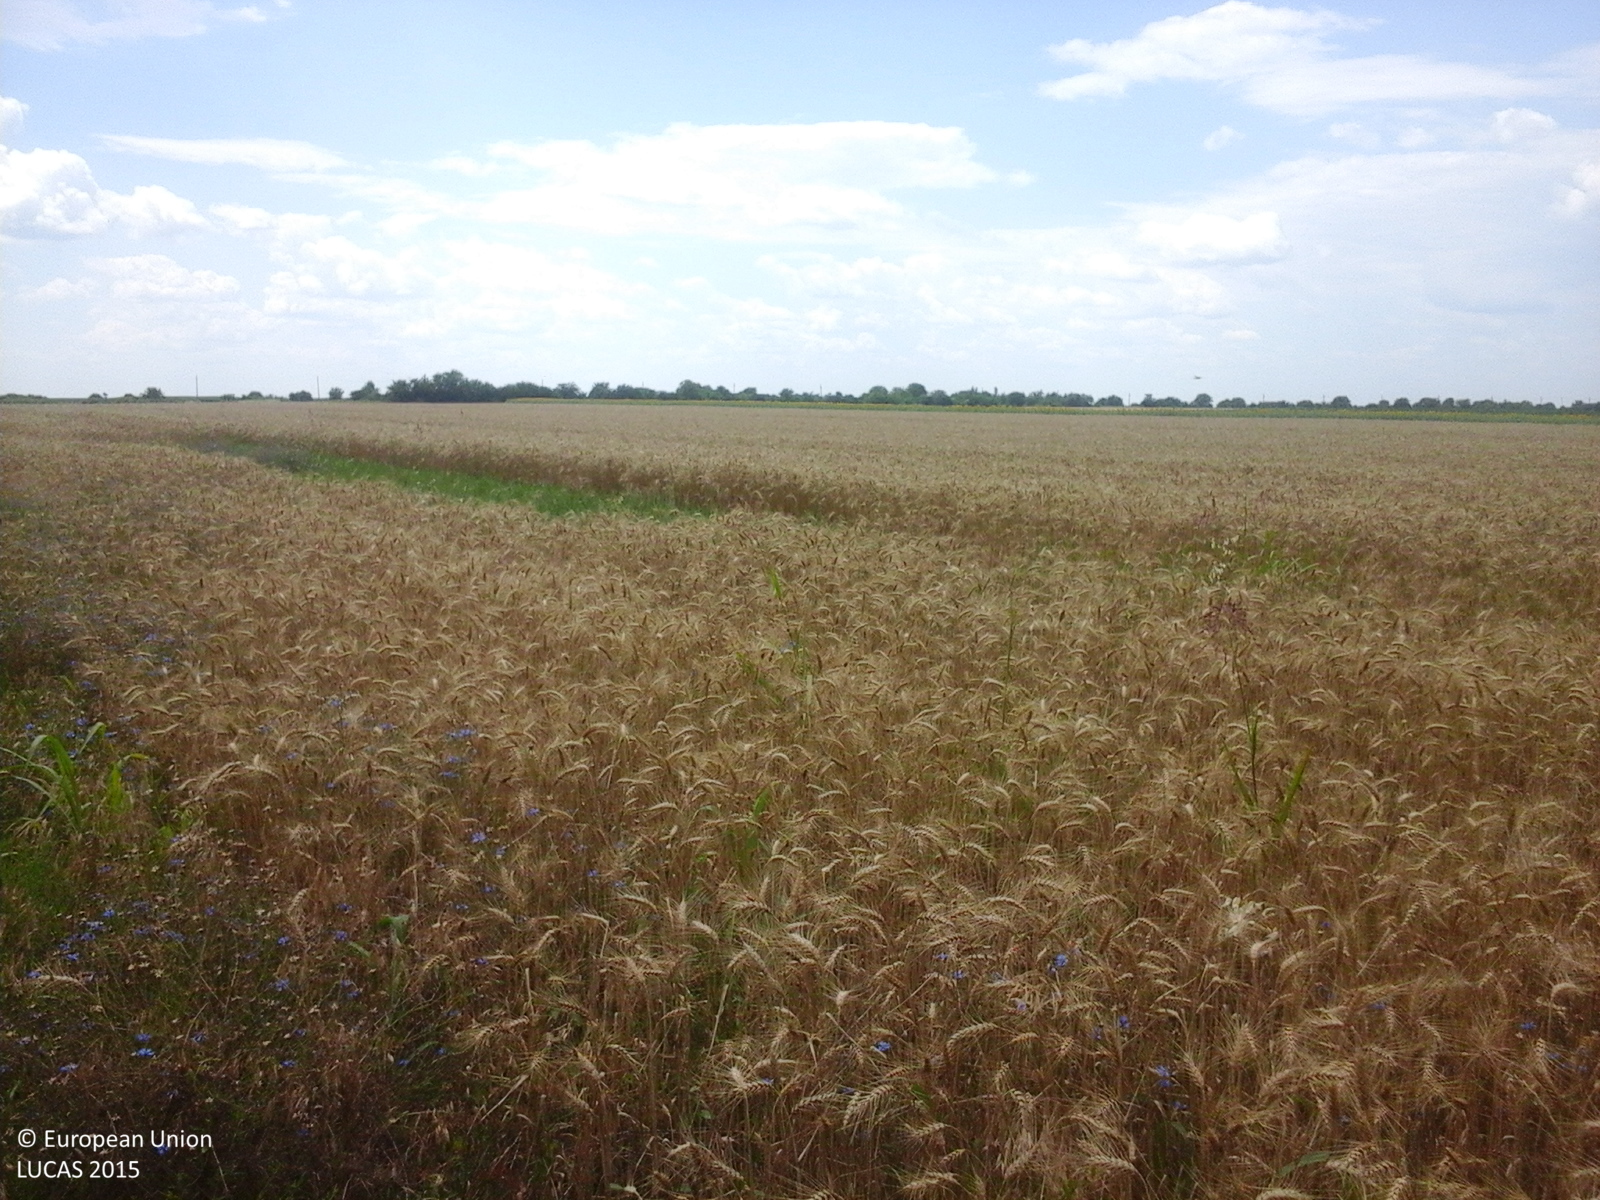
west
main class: Cropland
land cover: Maize
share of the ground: > 75 %
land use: Agriculture (excluding fallow land and kitchen gardens)
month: July
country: RO
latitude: 44.0143
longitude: 24.6769
